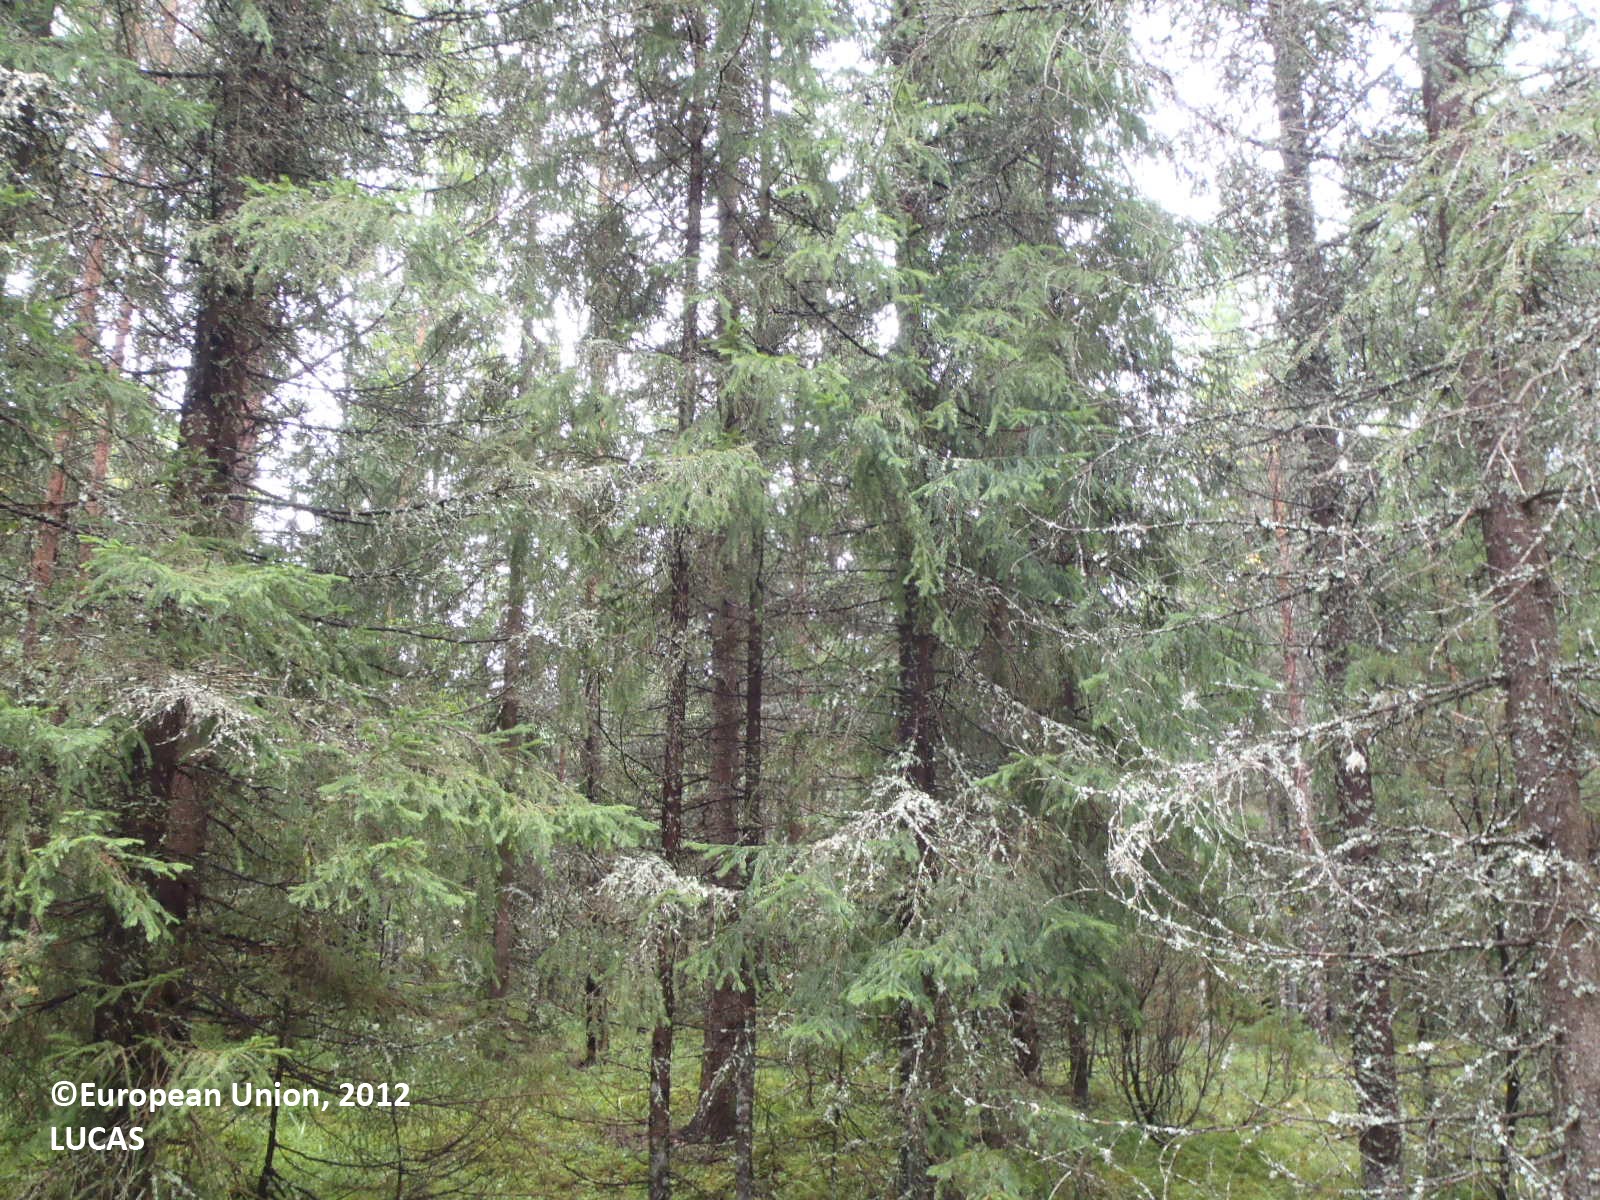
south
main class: Woodland
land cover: Spruce dominated coniferous woodland
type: boreal forest
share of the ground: > 75 %
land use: Forestry
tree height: > 5 m
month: August
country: FI
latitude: 60.7271
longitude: 22.1828
